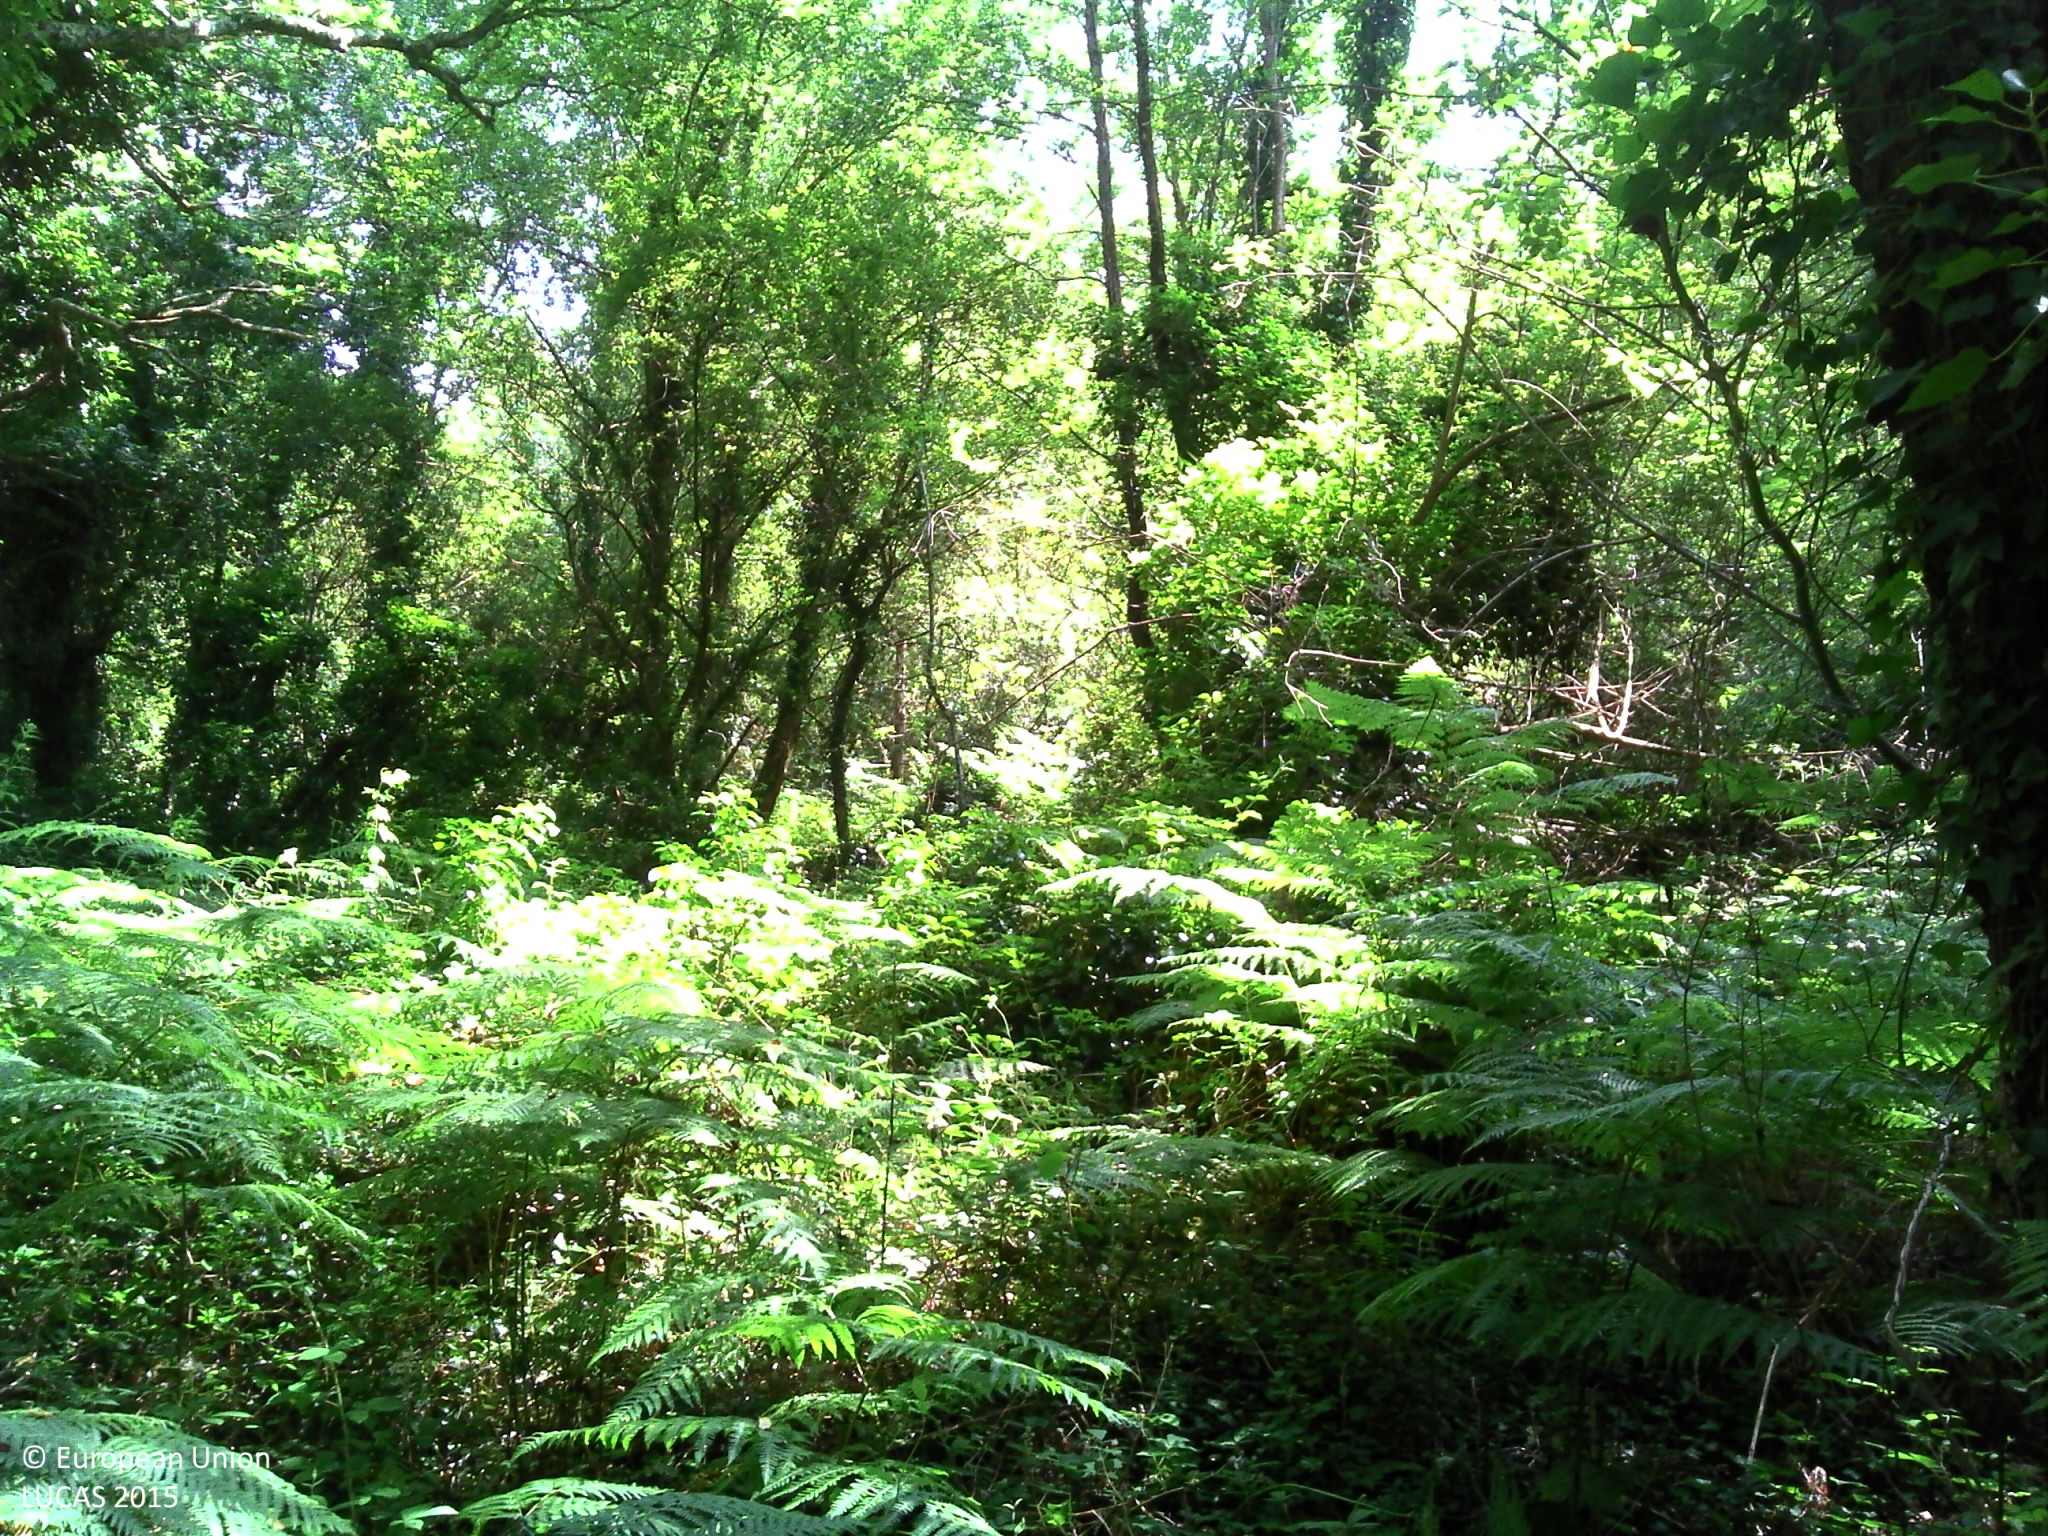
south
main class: Woodland
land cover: Broadleaved woodland
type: mesophytic deciduous forest
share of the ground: > 75 %
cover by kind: herbaceous plants 80 %, broadleaved forest trees 20 %
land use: Forestry
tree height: > 5 m
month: July
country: FR
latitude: 48.7911
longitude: -3.5153
